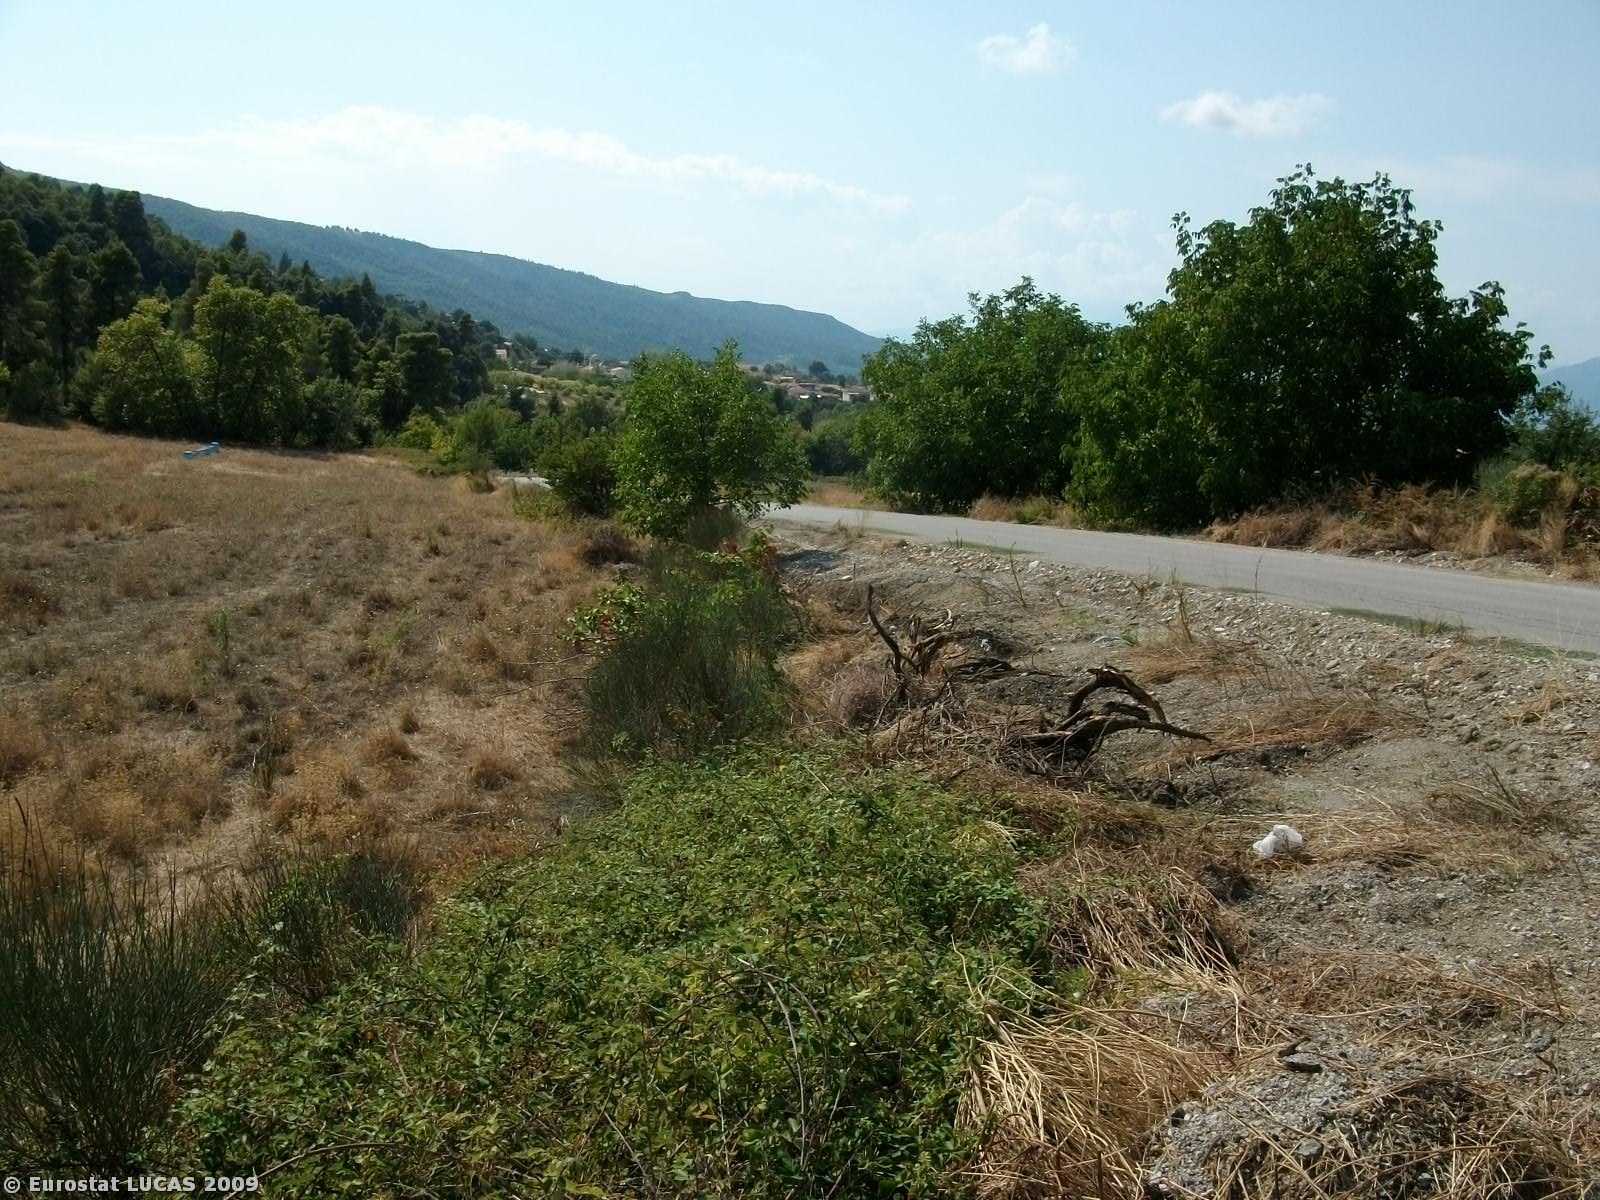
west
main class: Shrubland
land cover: Shrubland without tree cover
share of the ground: 25 - 50 %
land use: Fallow land
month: August
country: GR
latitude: 38.8995
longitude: 23.1668
